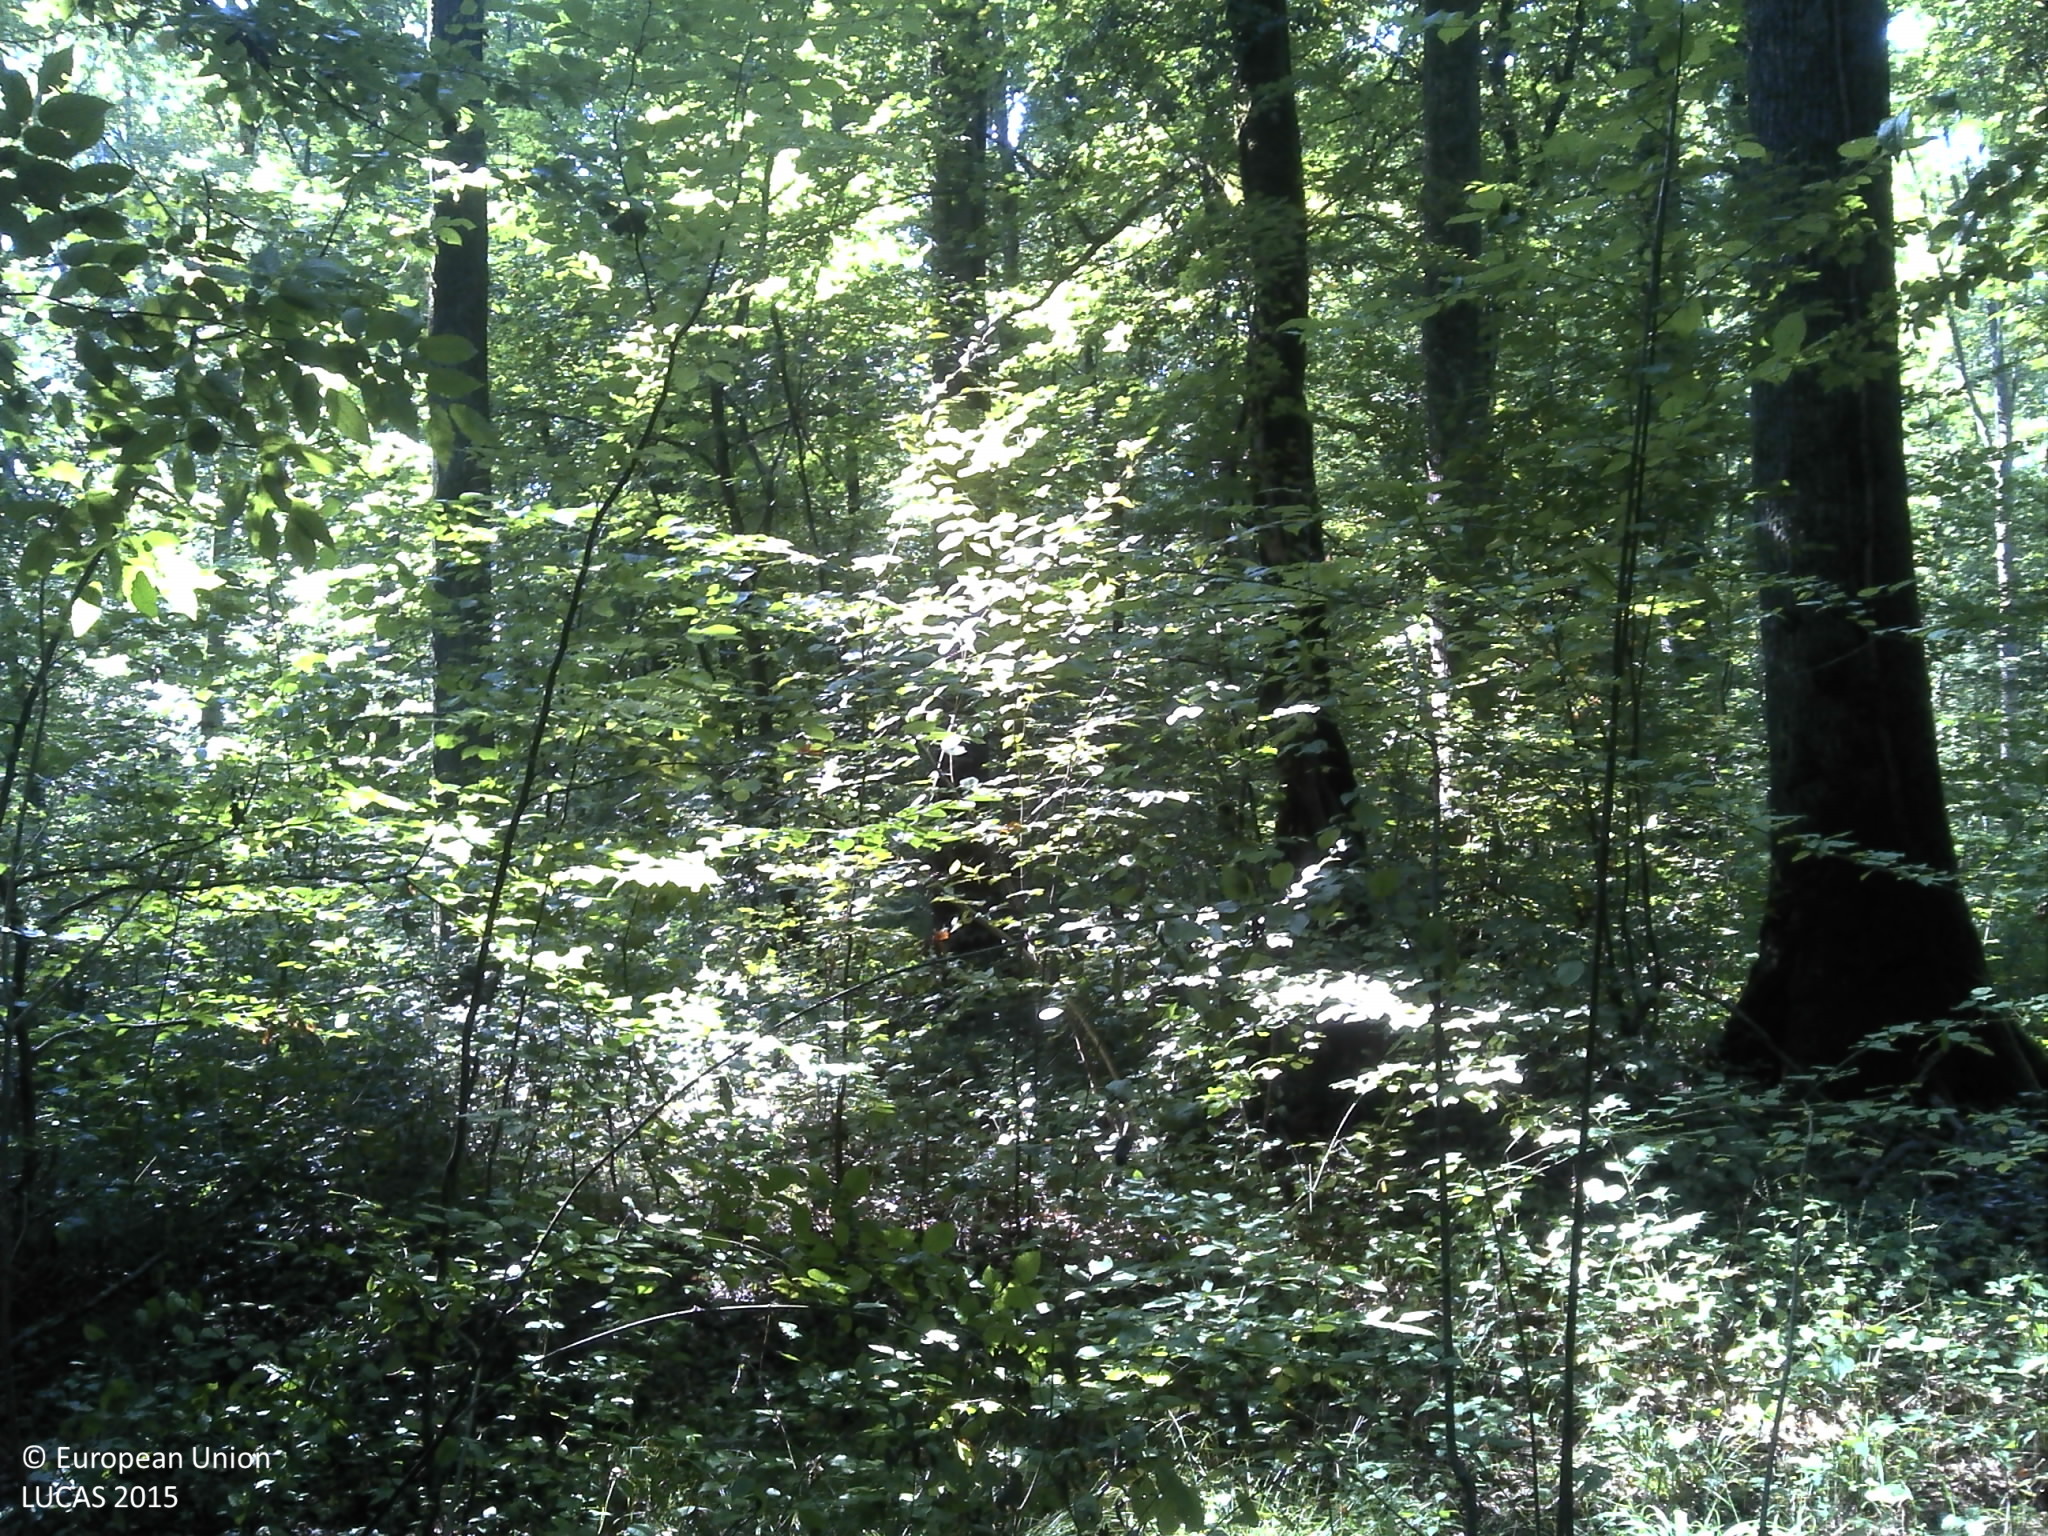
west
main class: Woodland
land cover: Broadleaved woodland
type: acidophilous oak and oak-birch forest
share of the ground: > 75 %
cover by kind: broadleaved forest trees 100 %
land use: Forestry
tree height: > 5 m
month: September
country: HR
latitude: 45.4996
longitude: 16.2556
